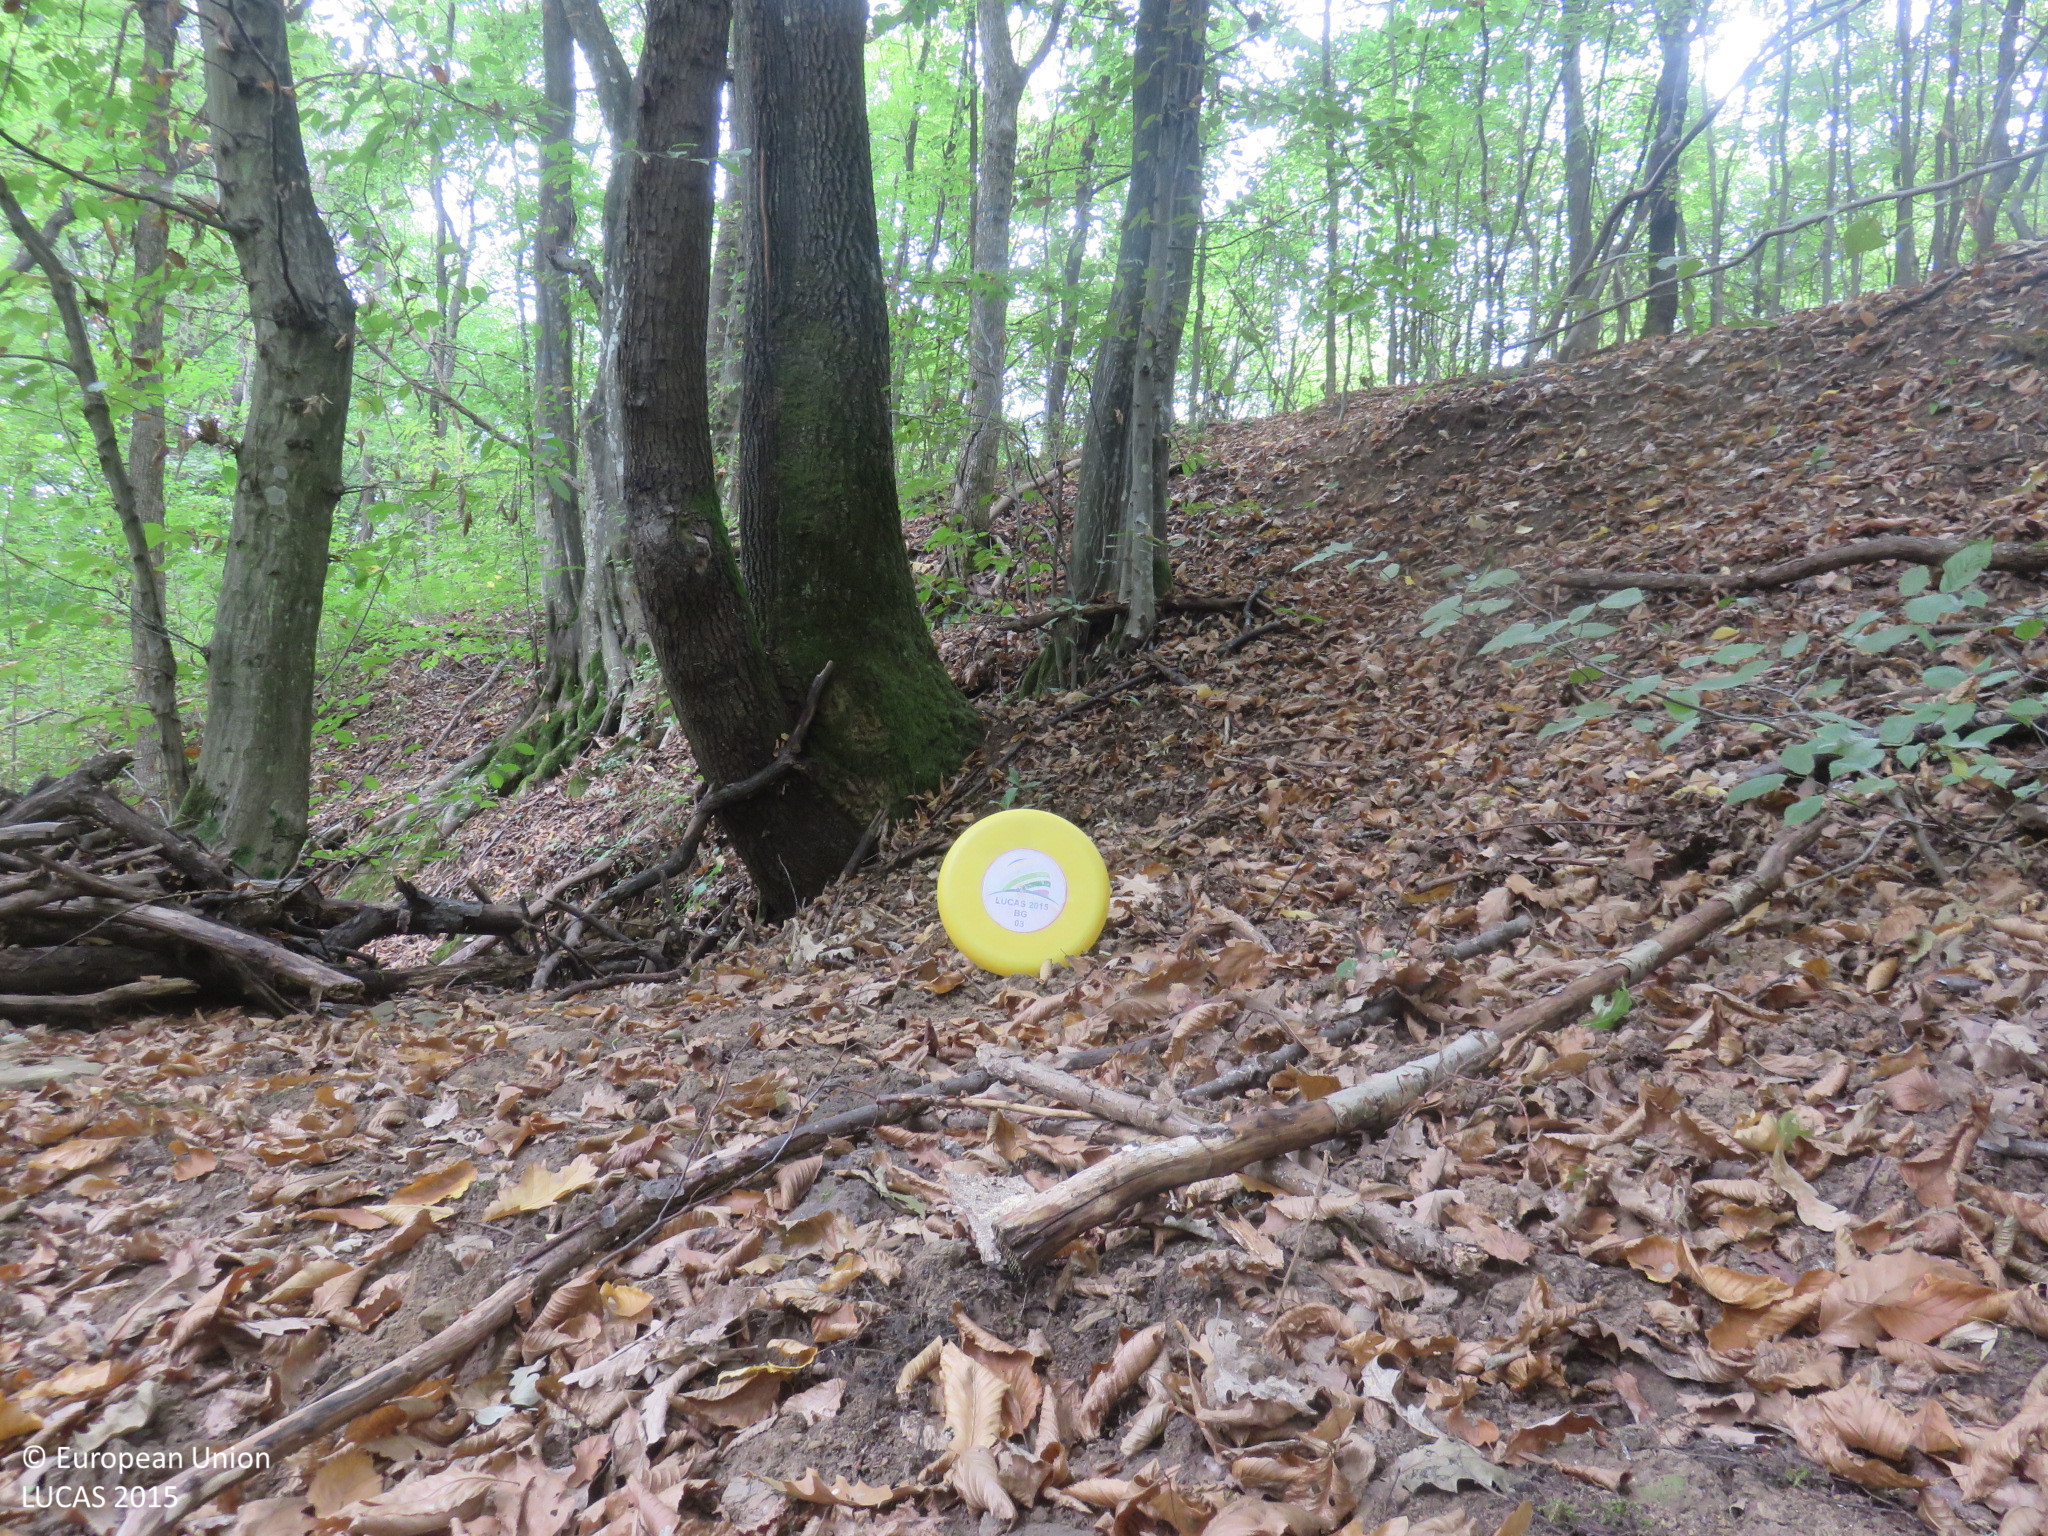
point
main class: Woodland
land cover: Broadleaved woodland
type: beech forest
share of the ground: > 75 %
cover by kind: broadleaved forest trees 85 %, unconsolidated bare surface 10 %, shrubs 5 %
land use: Forestry
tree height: > 5 m
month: September
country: BG
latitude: 43.0929
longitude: 24.8430
